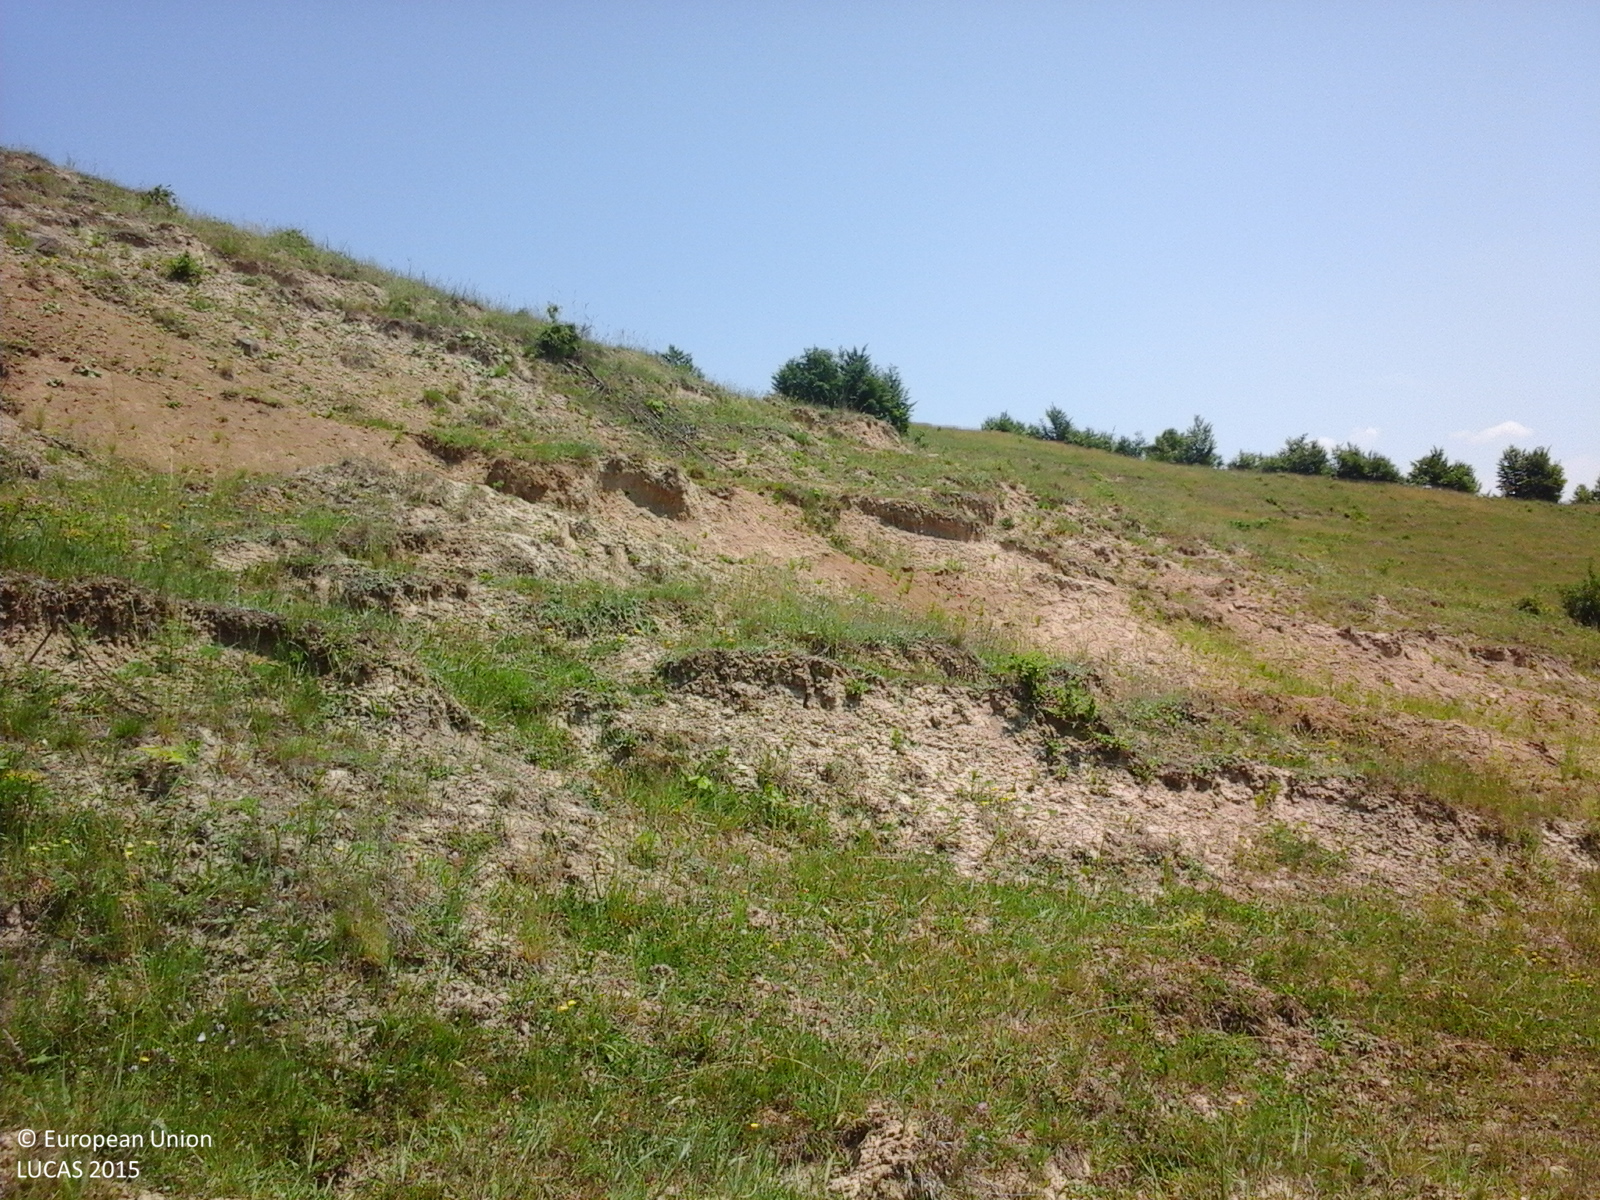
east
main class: Grassland
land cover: Grassland without tree/shrub cover
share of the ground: > 75 %
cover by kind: herbaceous plants 100 %
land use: Agriculture (excluding fallow land and kitchen gardens)
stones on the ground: < 10 %
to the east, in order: Grassland without tree/shrub cover; Abandoned hedges; Grassland without tree/shrub cover; Broadleaved woodland; Grassland without tree/shrub cover; Single bushes/trees; Grassland without tree/shrub cover; Broadleaved woodland
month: June
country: RO
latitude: 46.6726
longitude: 26.5147
